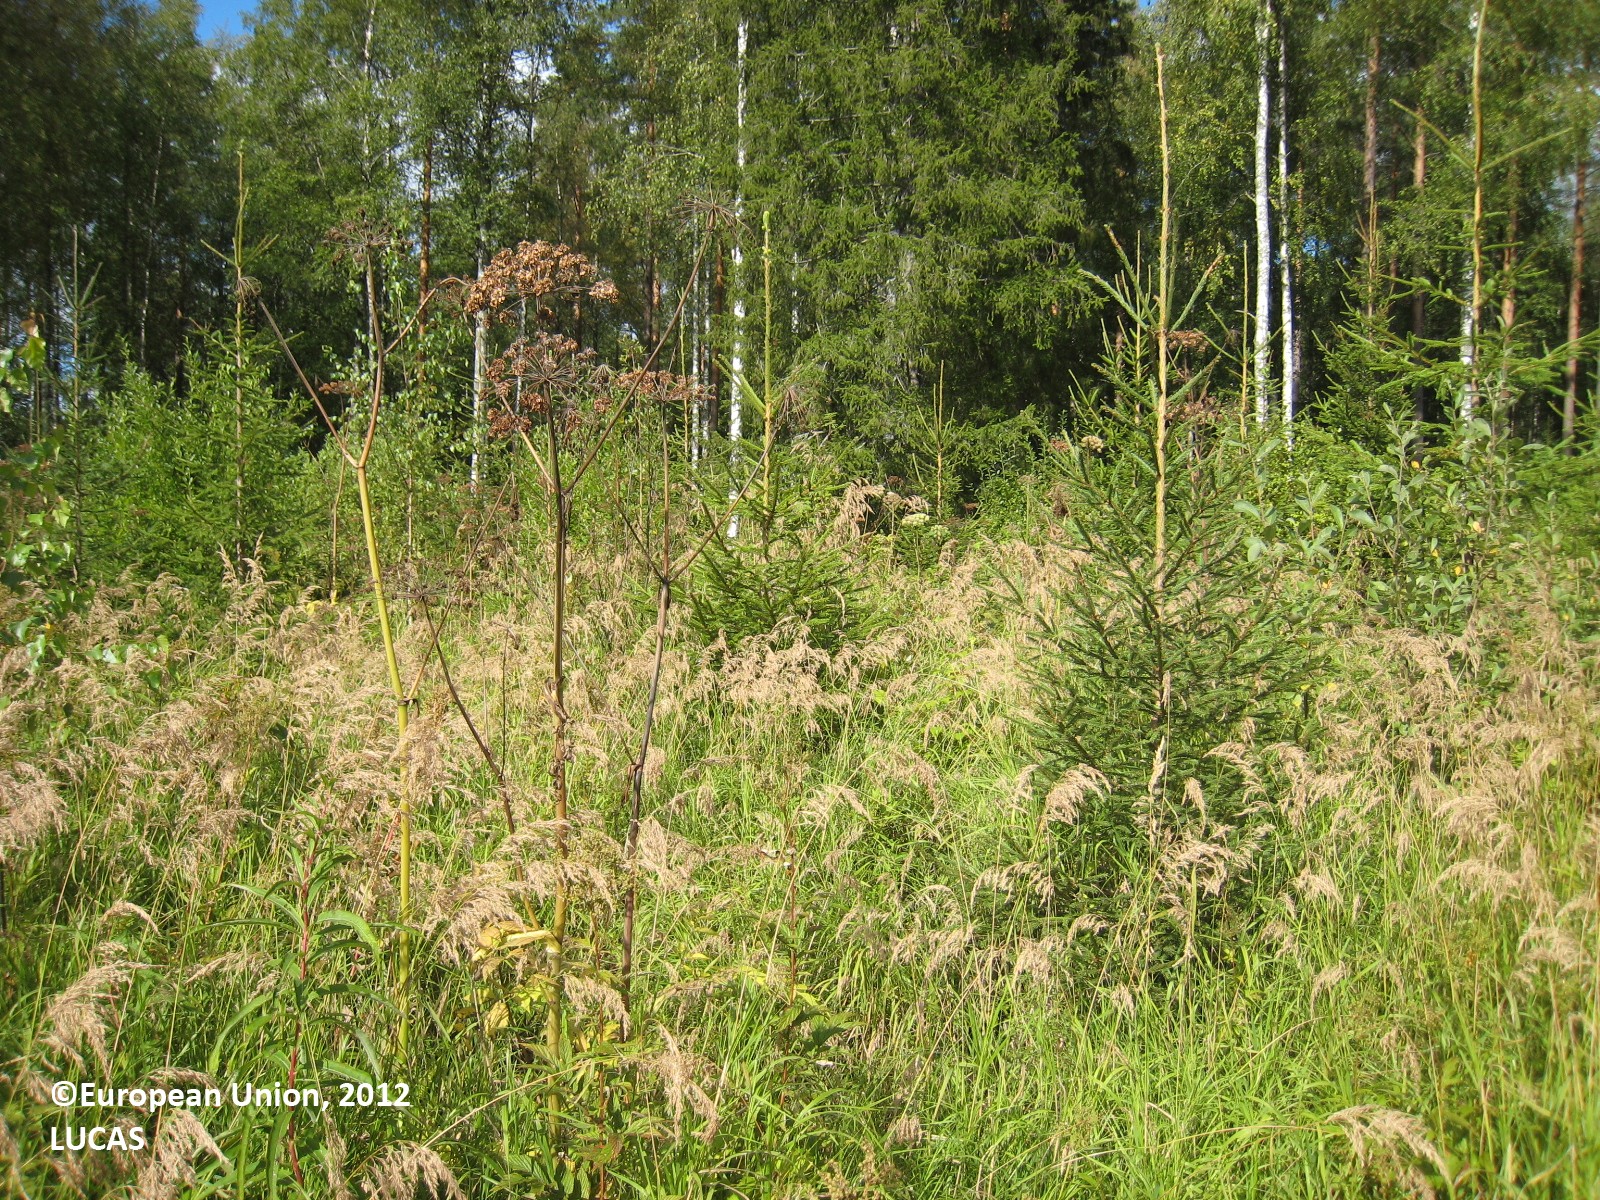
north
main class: Woodland
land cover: Spruce dominated mixed woodland
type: boreal forest
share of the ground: 50 - 75 %
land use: Forestry
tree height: < 5 m
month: August
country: FI
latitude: 61.9807
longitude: 27.2035
